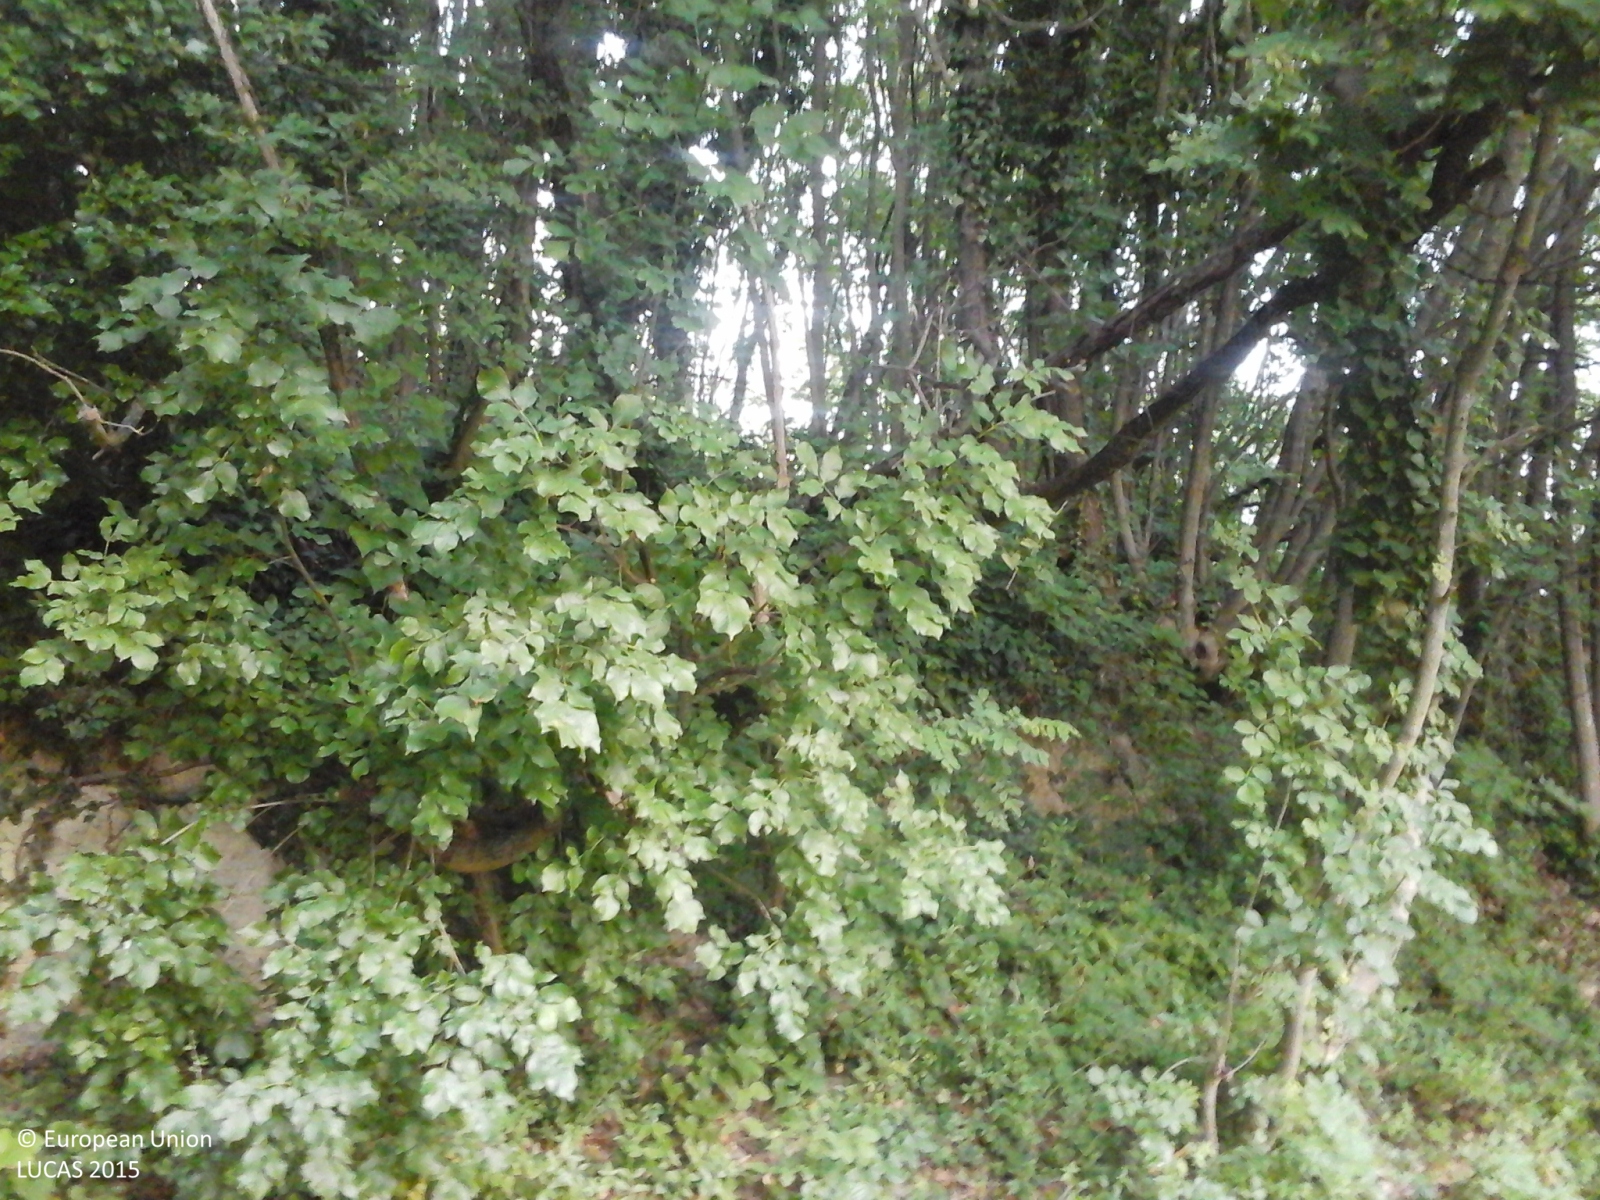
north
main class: Woodland
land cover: Broadleaved woodland
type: thermophilous deciduous forest
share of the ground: > 75 %
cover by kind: broadleaved forest trees 100 %
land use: Semi-natural and natural areas not in use
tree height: > 5 m
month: June
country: IT
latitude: 45.0583
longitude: 8.3142
